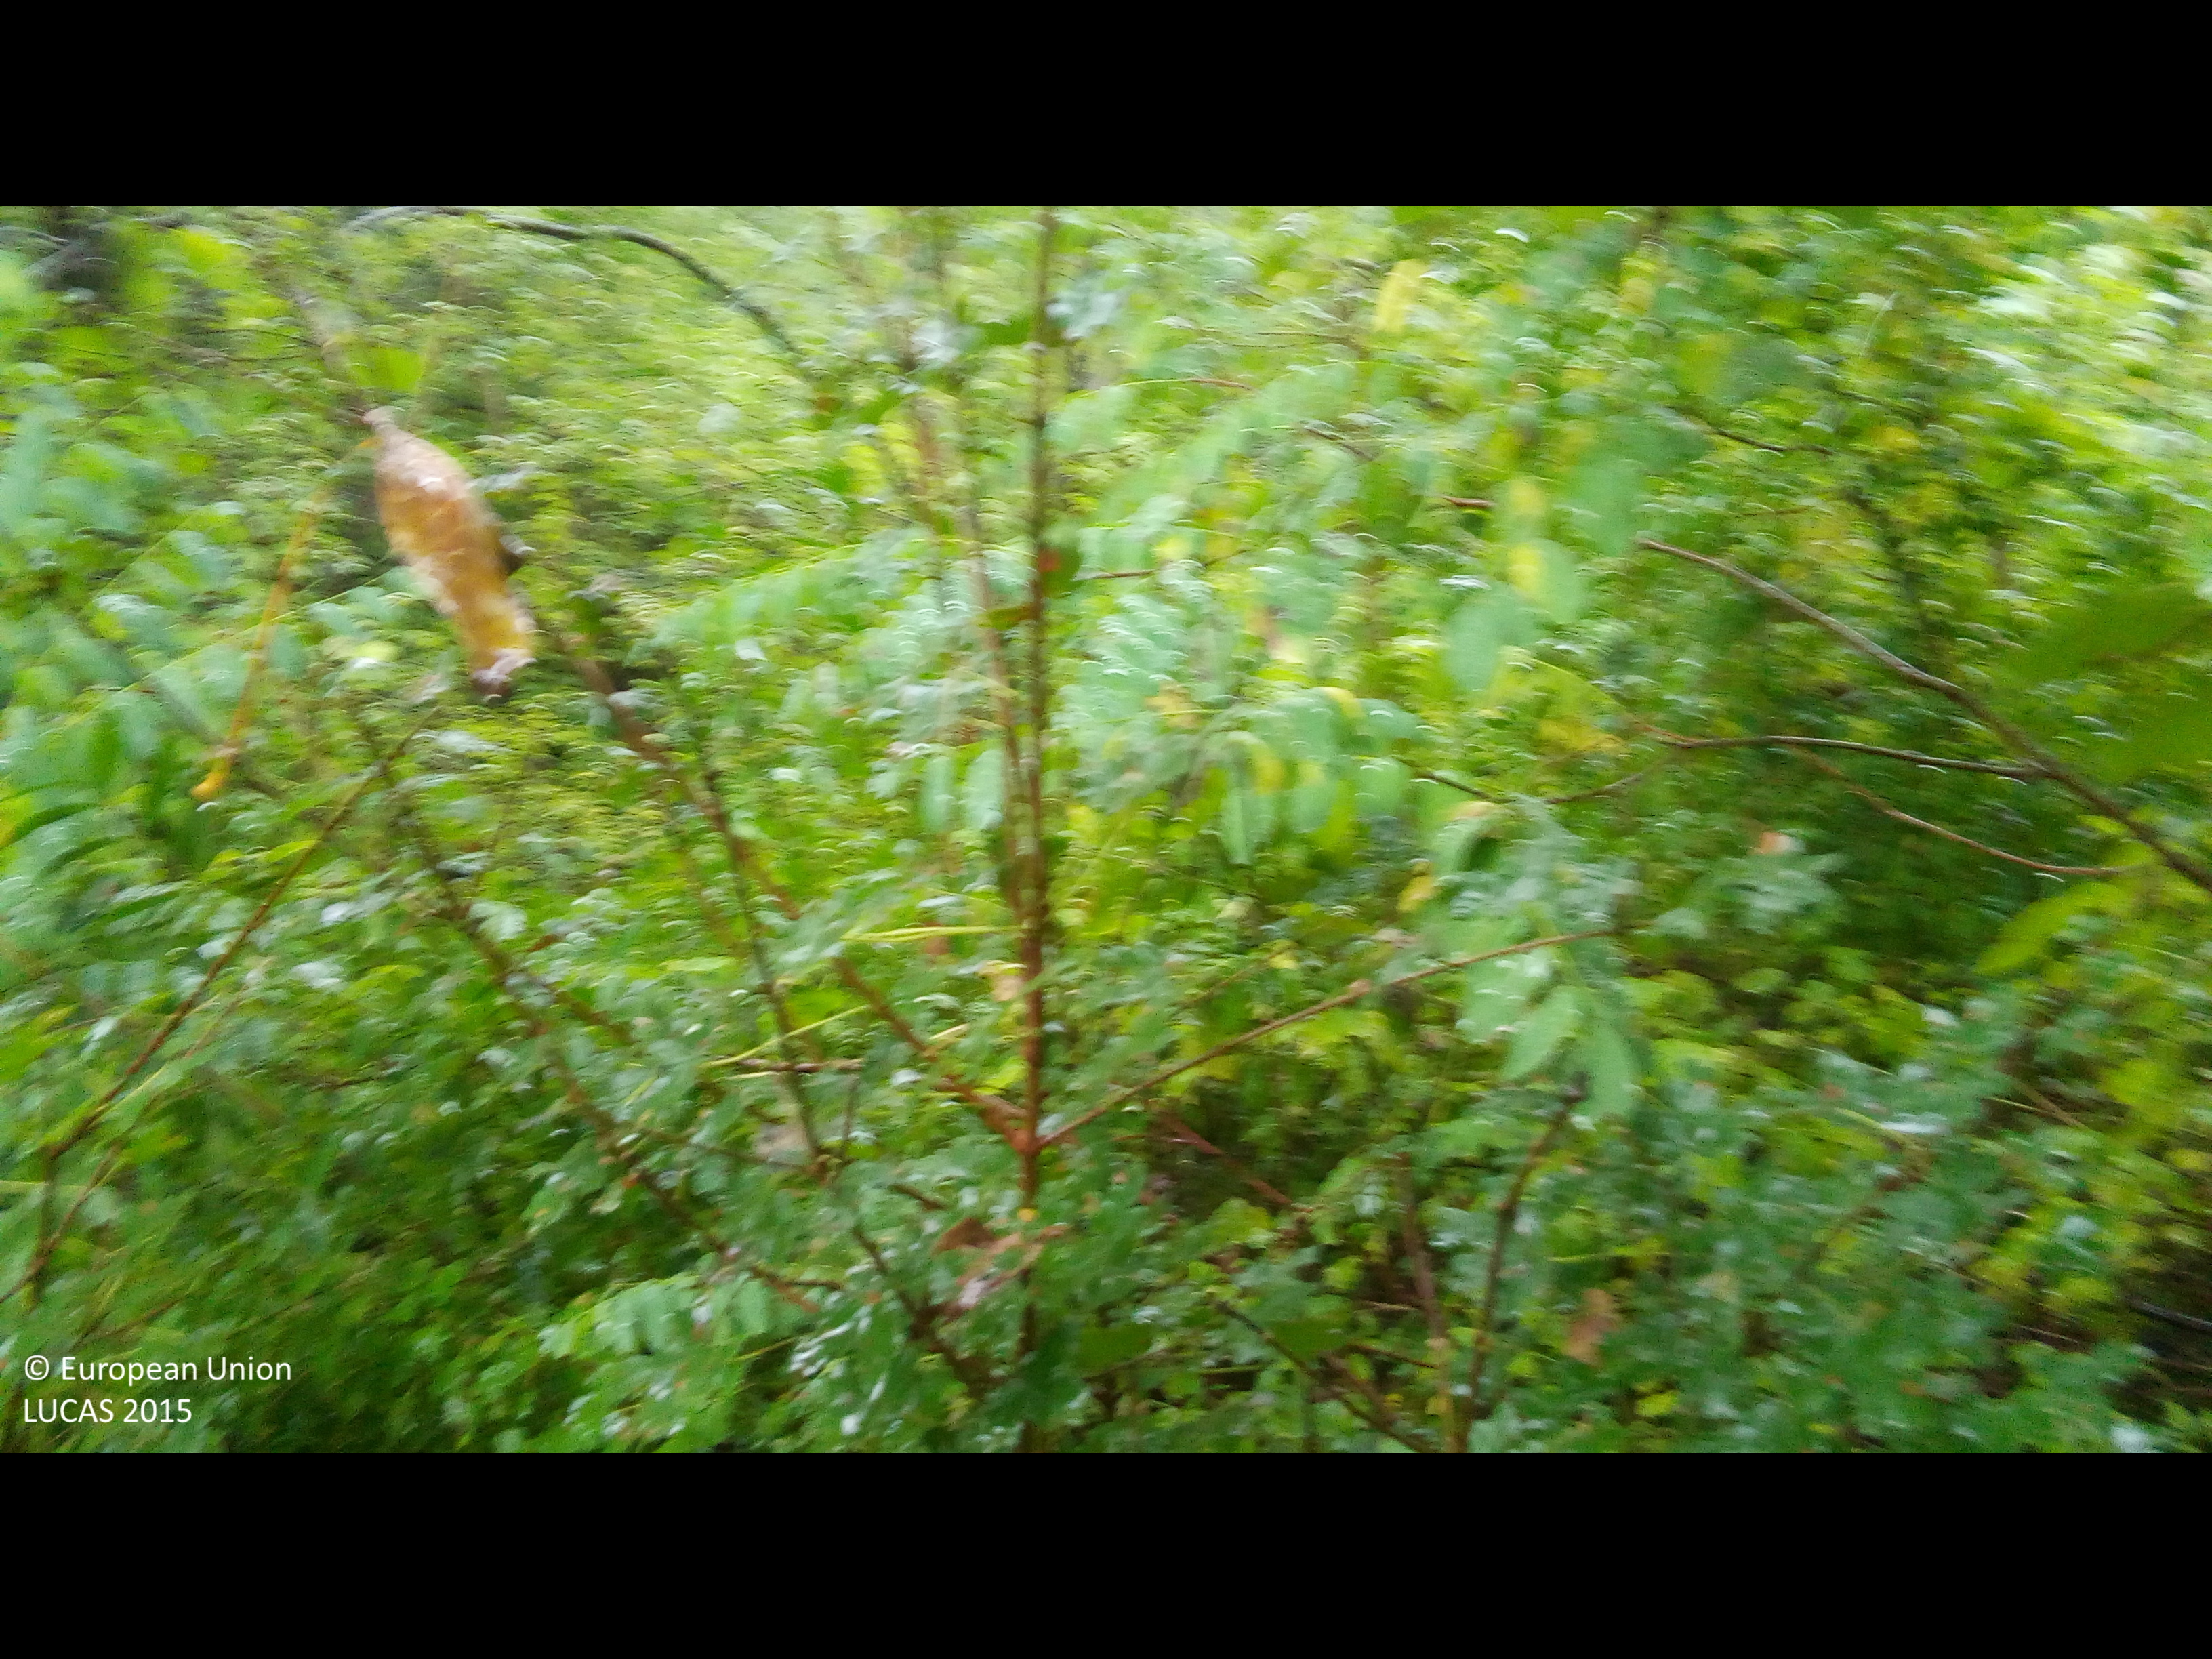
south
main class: Woodland
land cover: Broadleaved woodland
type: beech forest
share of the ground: > 75 %
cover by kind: broadleaved forest trees 90 %, shrubs 5 %, herbaceous plants 5 %
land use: Forestry
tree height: > 5 m
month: October
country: BG
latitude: 42.5784
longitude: 23.4245
